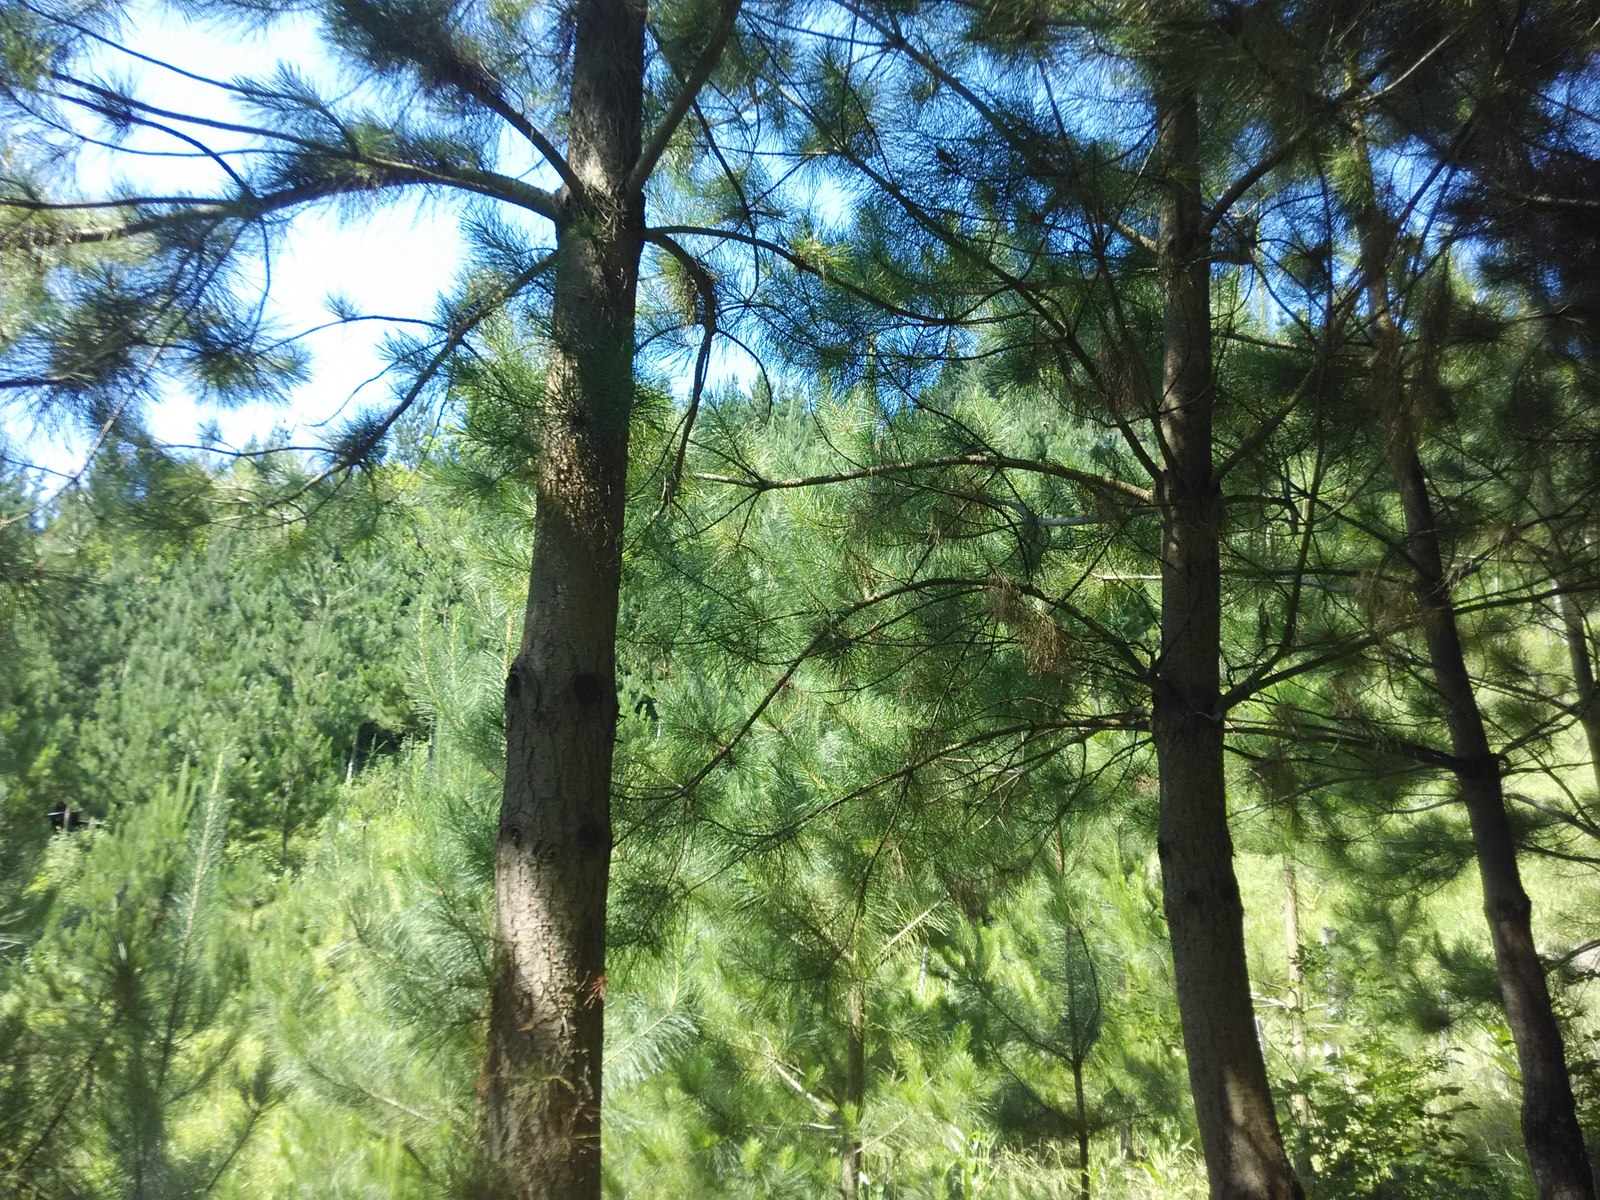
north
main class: Woodland
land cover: Pine dominated coniferous woodland
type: exotic forest
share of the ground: > 75 %
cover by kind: coniferous forest trees 80 %, herbaceous plants 15 %, shrubs 5 %
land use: Forestry
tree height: < 5 m
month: June
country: ES
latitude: 43.0430
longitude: -2.5105
